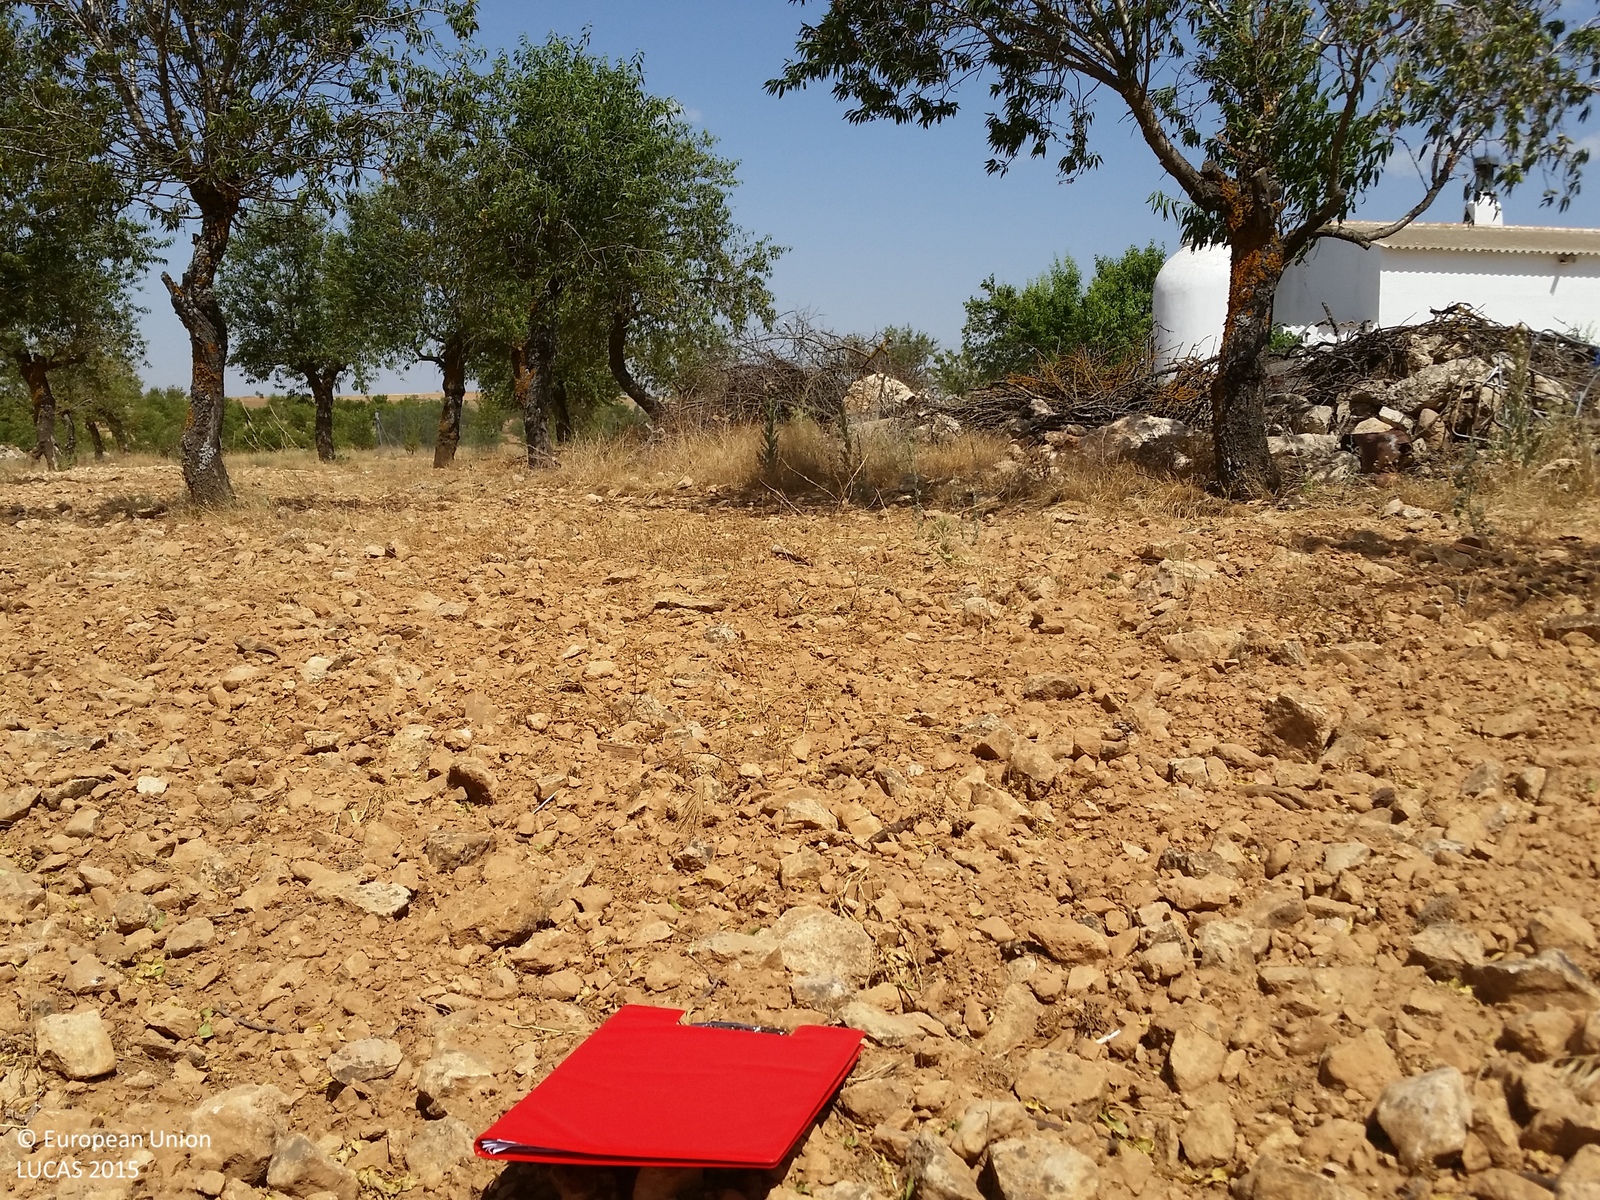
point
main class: Cropland
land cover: Nuts trees
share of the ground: 50 - 75 %
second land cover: Spontaneously vegetated surfaces
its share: 25 - 50 %
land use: Agriculture (excluding fallow land and kitchen gardens)
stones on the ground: 10 - 25 %
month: July
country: ES
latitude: 38.8955
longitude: -2.5142
